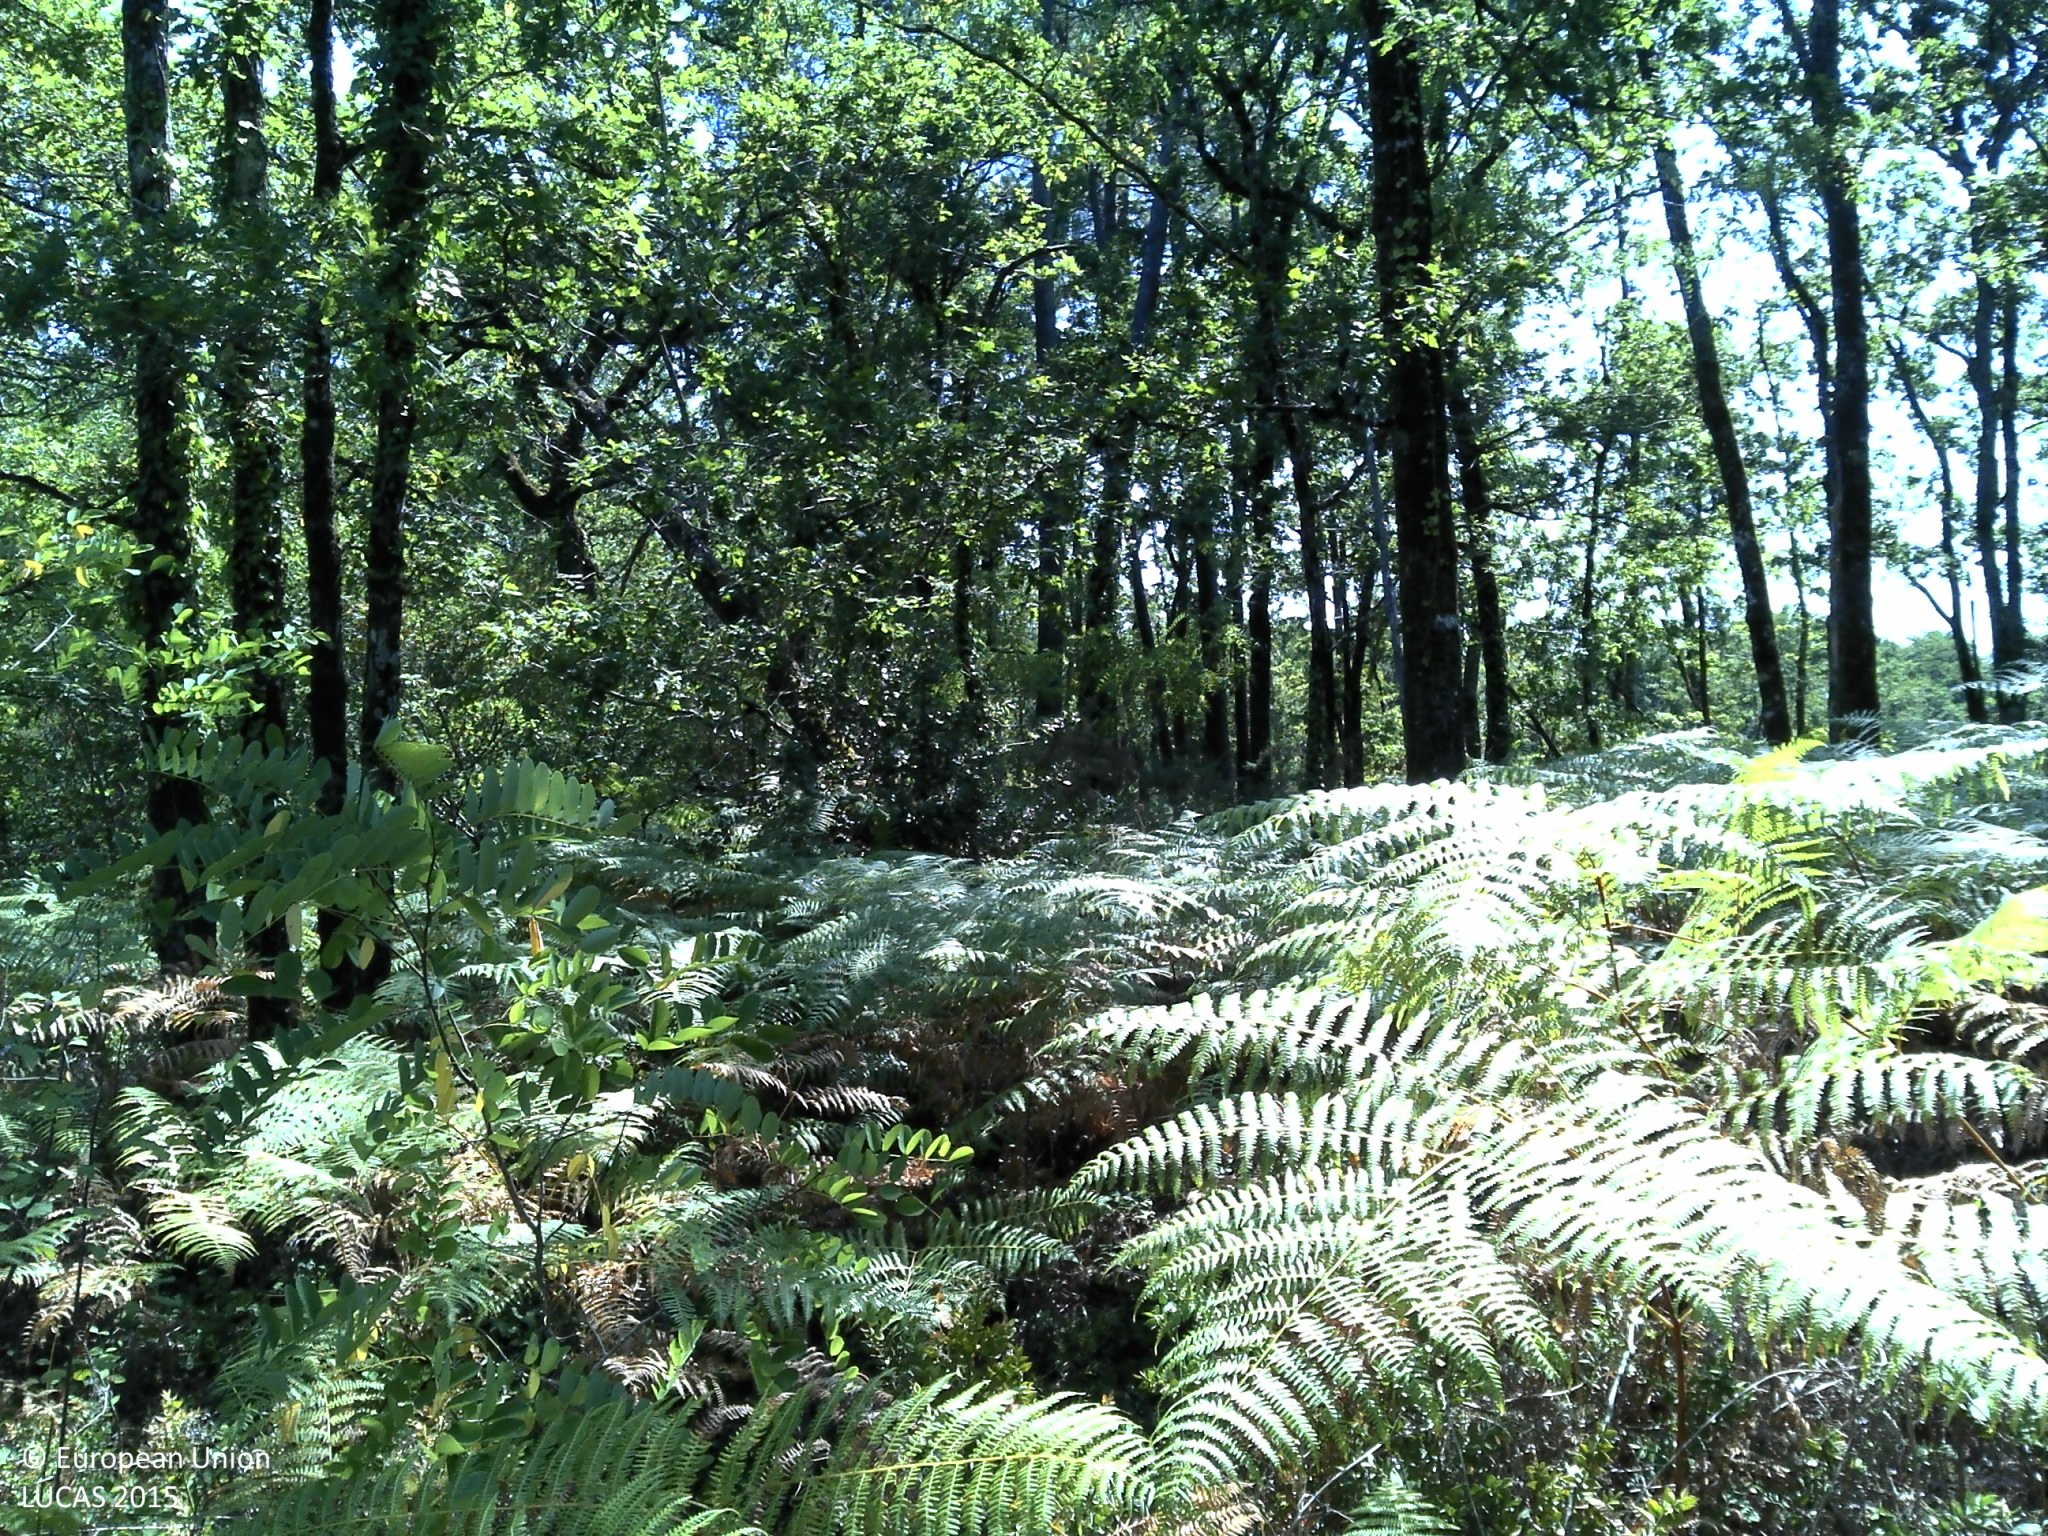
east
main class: Woodland
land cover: Broadleaved woodland
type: thermophilous deciduous forest
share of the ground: > 75 %
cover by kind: shrubs 50 %, broadleaved forest trees 30 %, herbaceous plants 20 %
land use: Forestry
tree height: > 5 m
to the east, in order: Broadleaved woodland; Tracks; Broadleaved woodland
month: August
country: FR
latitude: 45.0474
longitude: -0.7242
